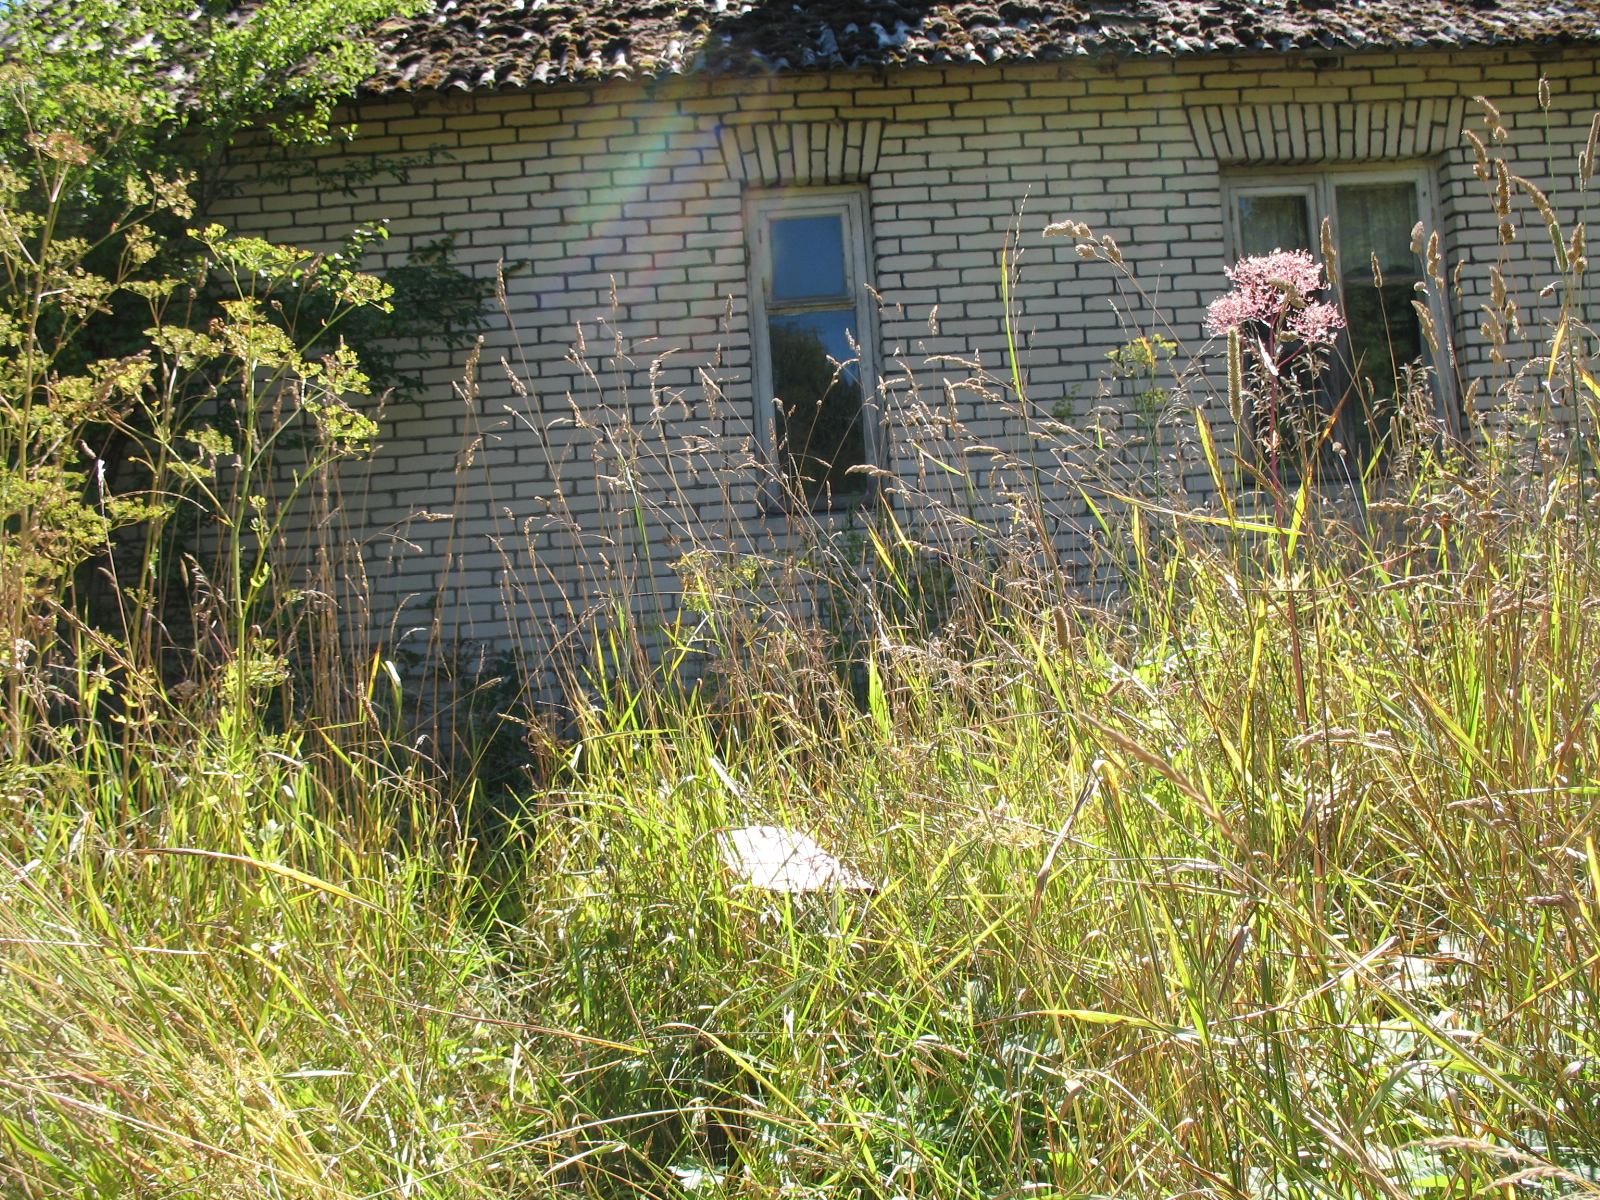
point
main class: Grassland
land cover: Grassland without tree/shrub cover
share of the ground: > 75 %
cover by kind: herbaceous plants 100 %
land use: Residential
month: August
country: LV
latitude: 56.5265
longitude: 25.6157
